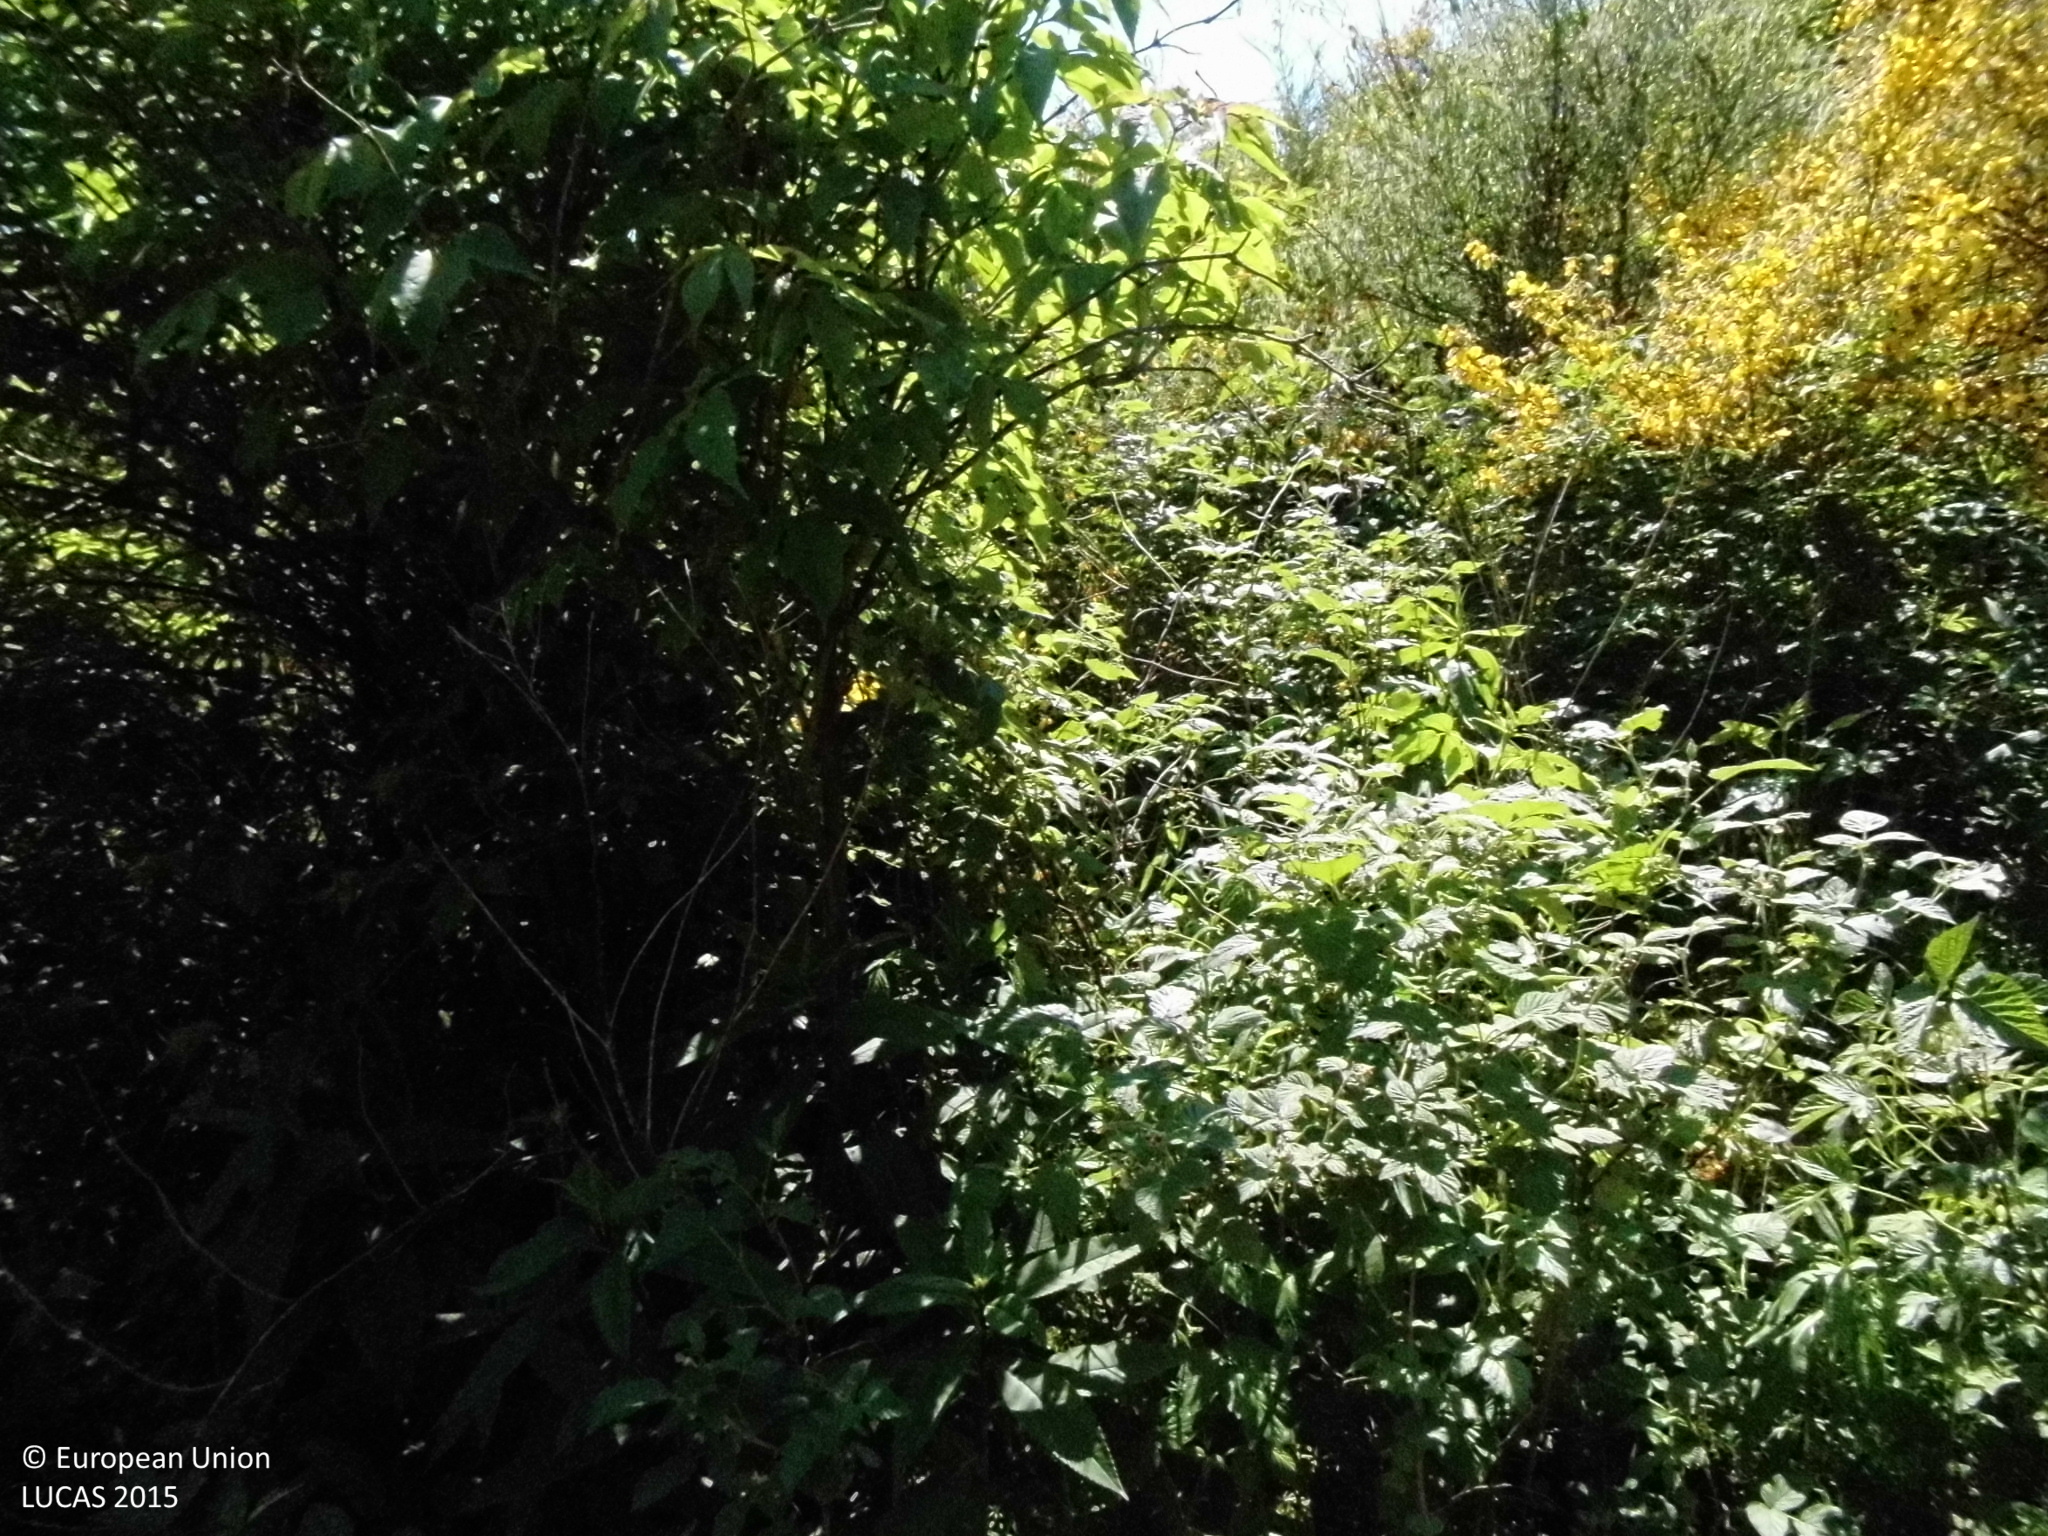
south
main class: Shrubland
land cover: Shrubland with sparse tree cover
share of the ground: > 75 %
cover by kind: shrubs 85 %, herbaceous plants 10 %, broadleaved forest trees 5 %
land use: Semi-natural and natural areas not in use
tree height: < 5 m
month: June
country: DE
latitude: 50.8516
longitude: 8.0828
